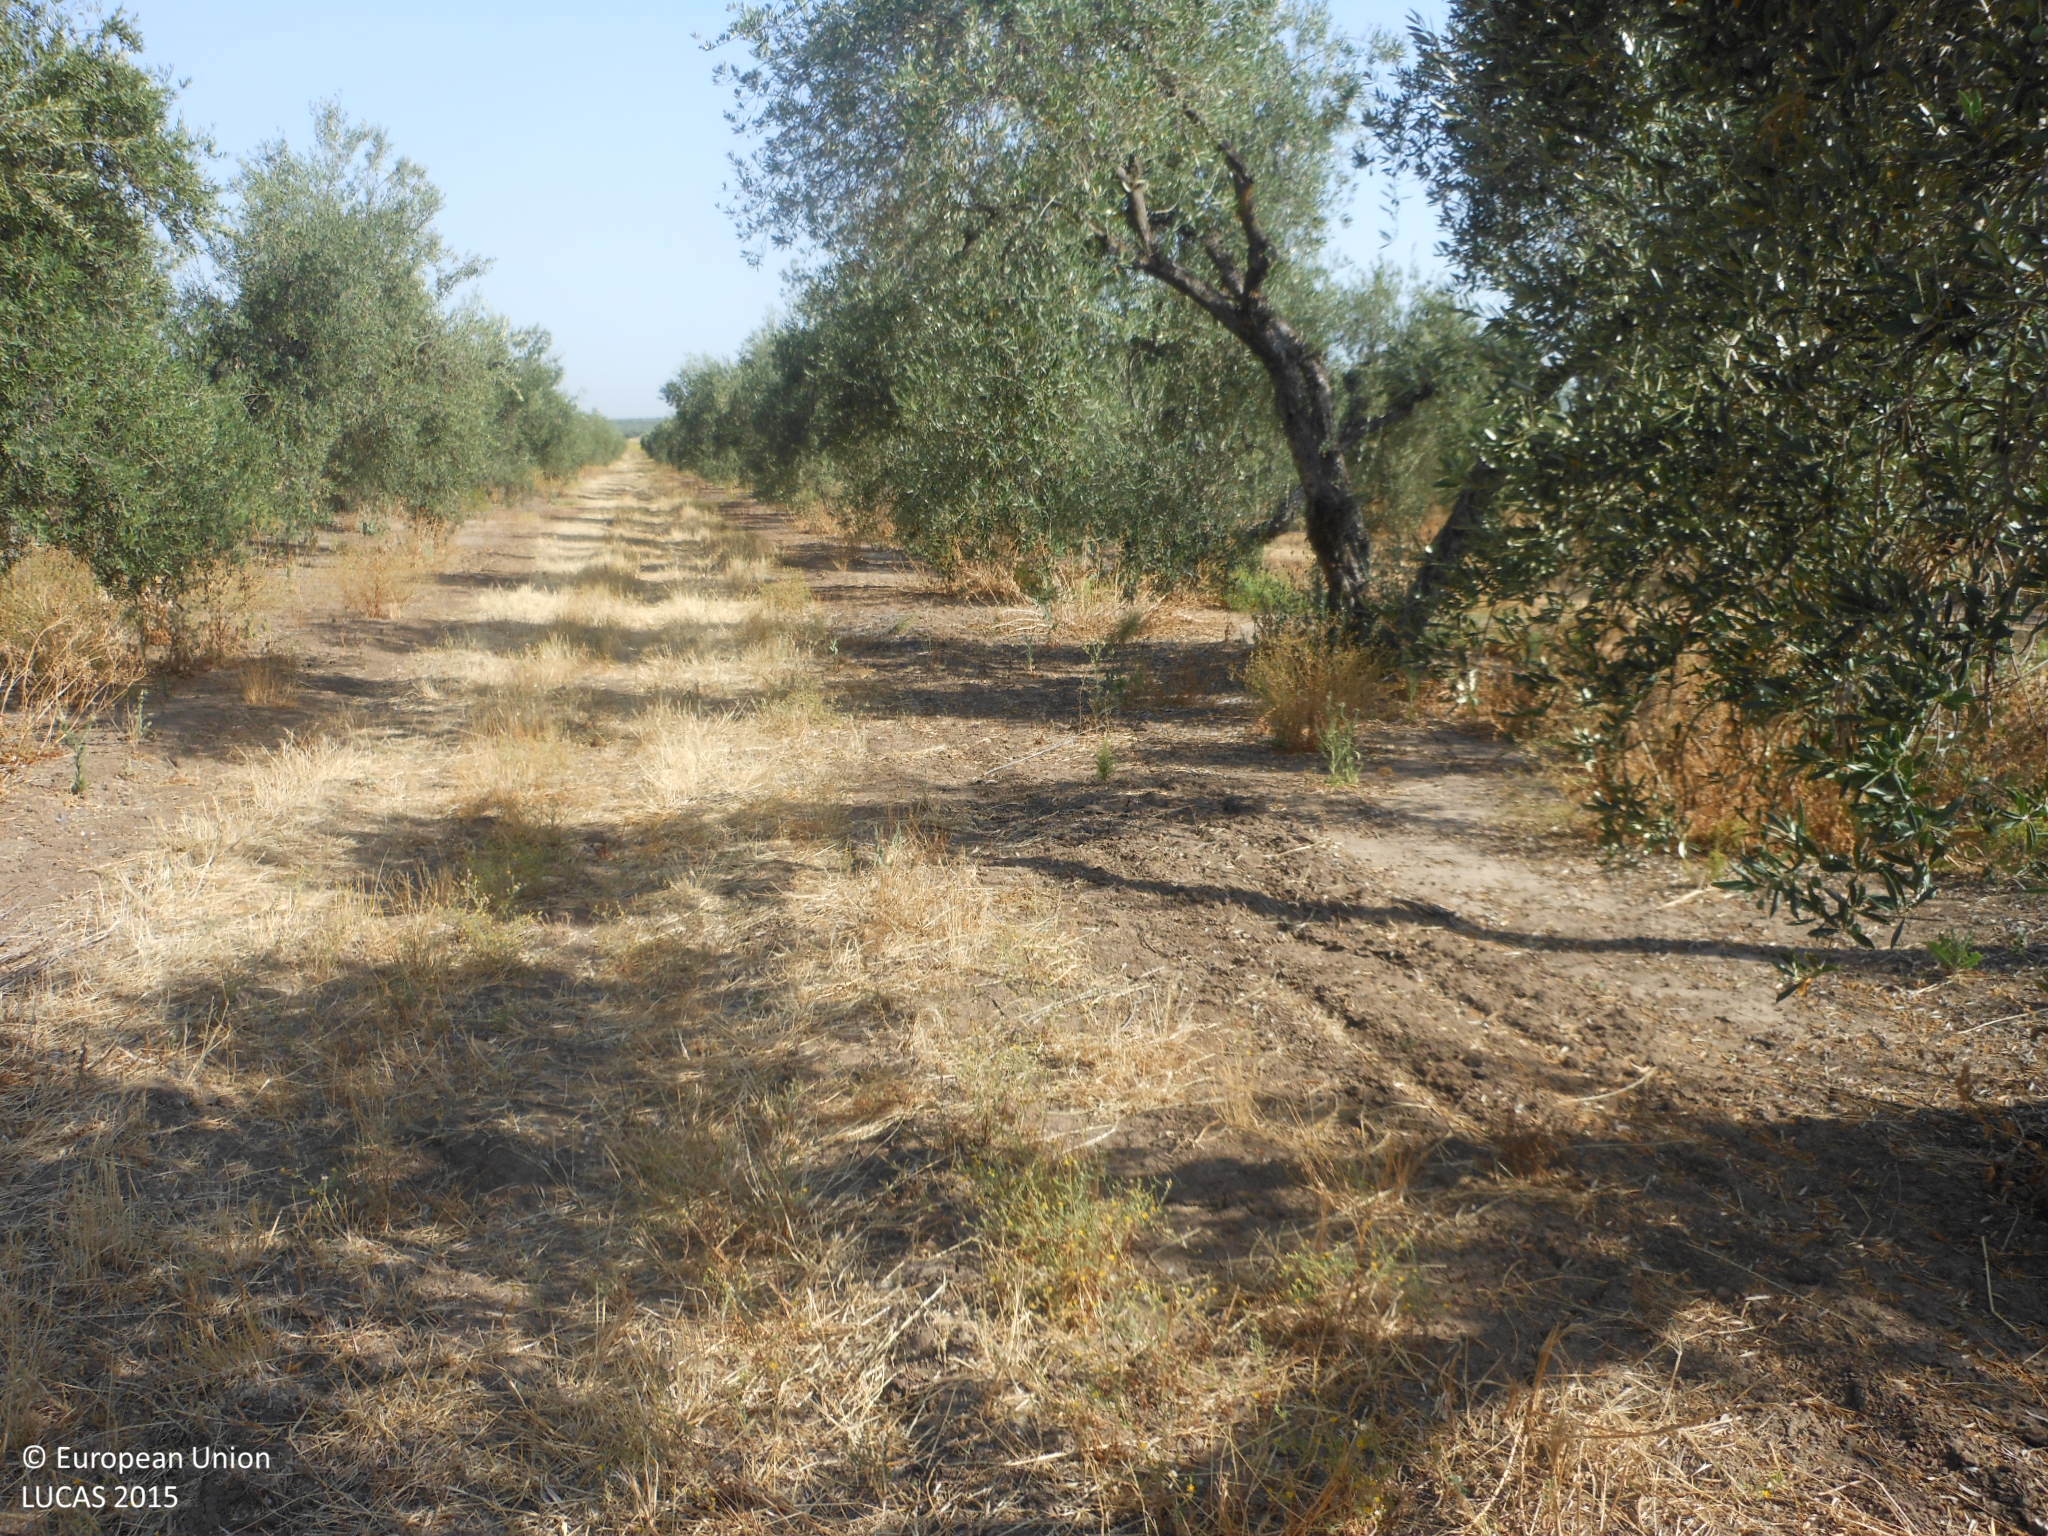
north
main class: Cropland
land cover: Olive groves
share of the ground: 50 - 75 %
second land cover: Spontaneously vegetated surfaces
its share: 25 - 50 %
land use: Agriculture (excluding fallow land and kitchen gardens)
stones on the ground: 10 - 25 %
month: June
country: ES
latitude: 37.1793
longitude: -5.5451
